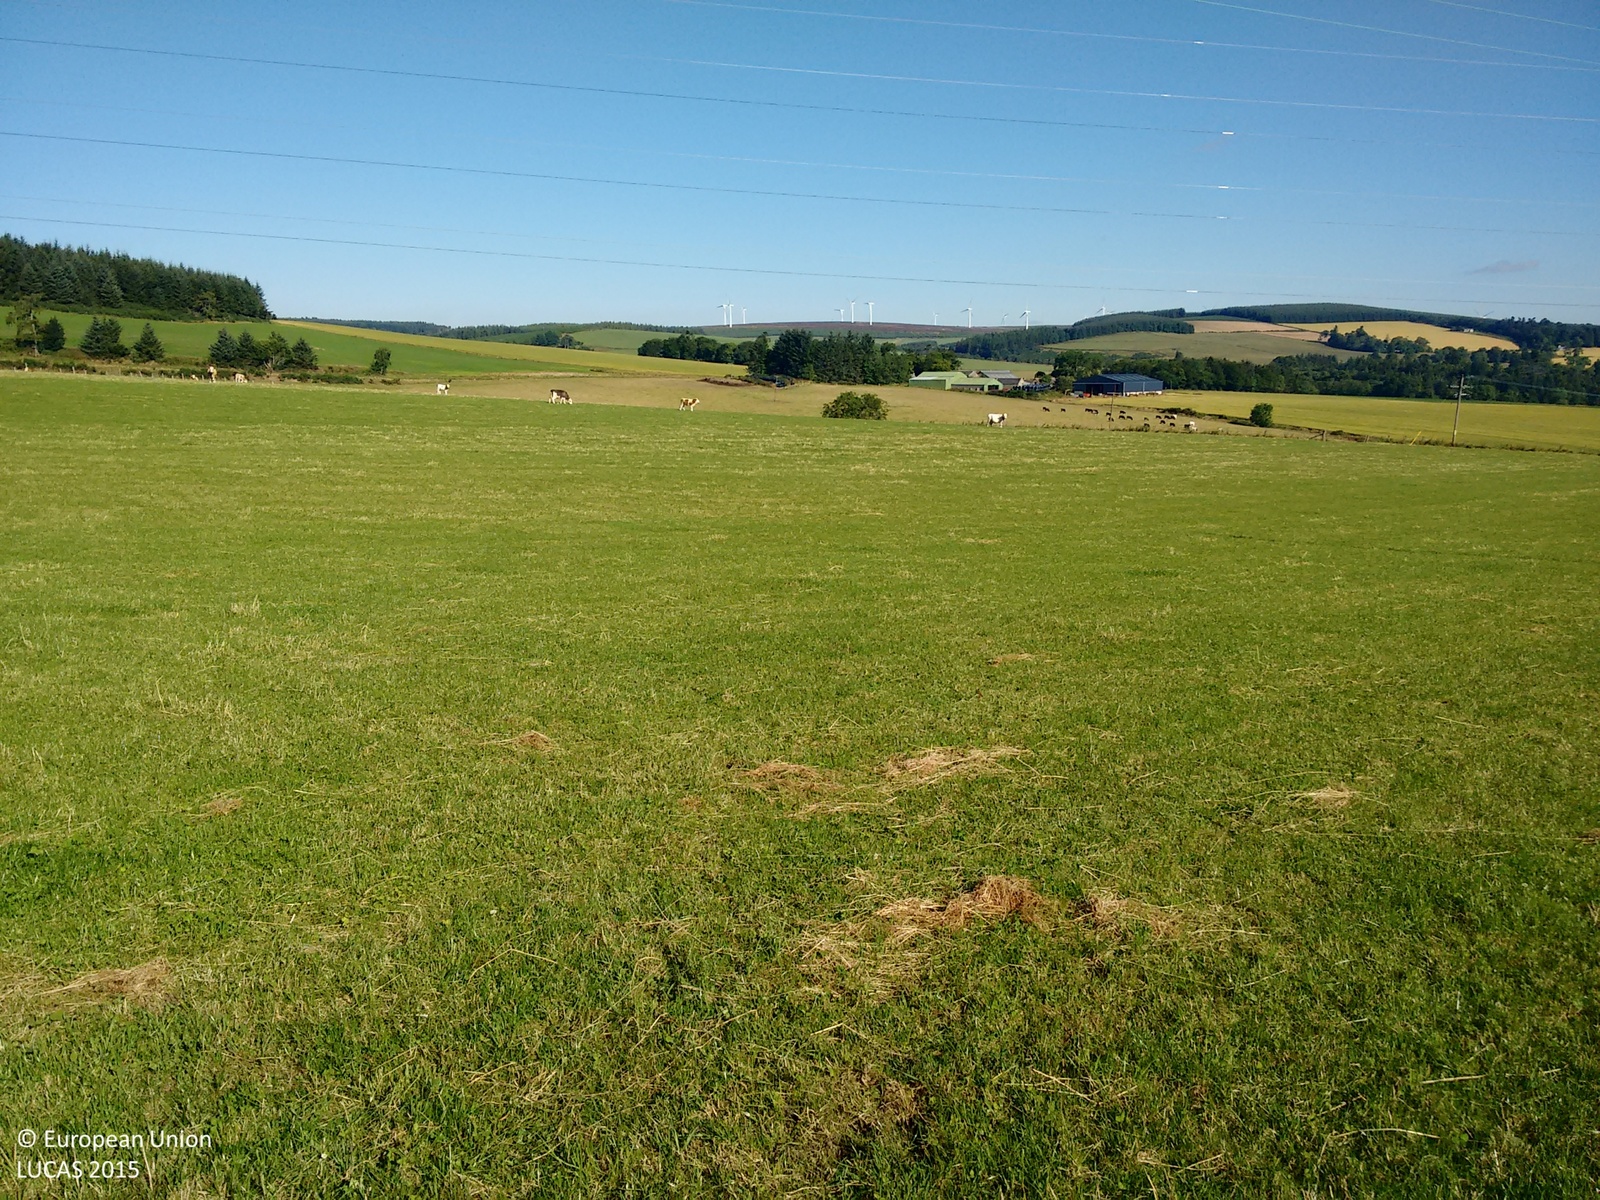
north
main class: Grassland
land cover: Grassland without tree/shrub cover
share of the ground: > 75 %
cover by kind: herbaceous plants 100 %
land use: Agriculture (excluding fallow land and kitchen gardens)
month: August
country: GB
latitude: 57.4700
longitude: -3.0509
